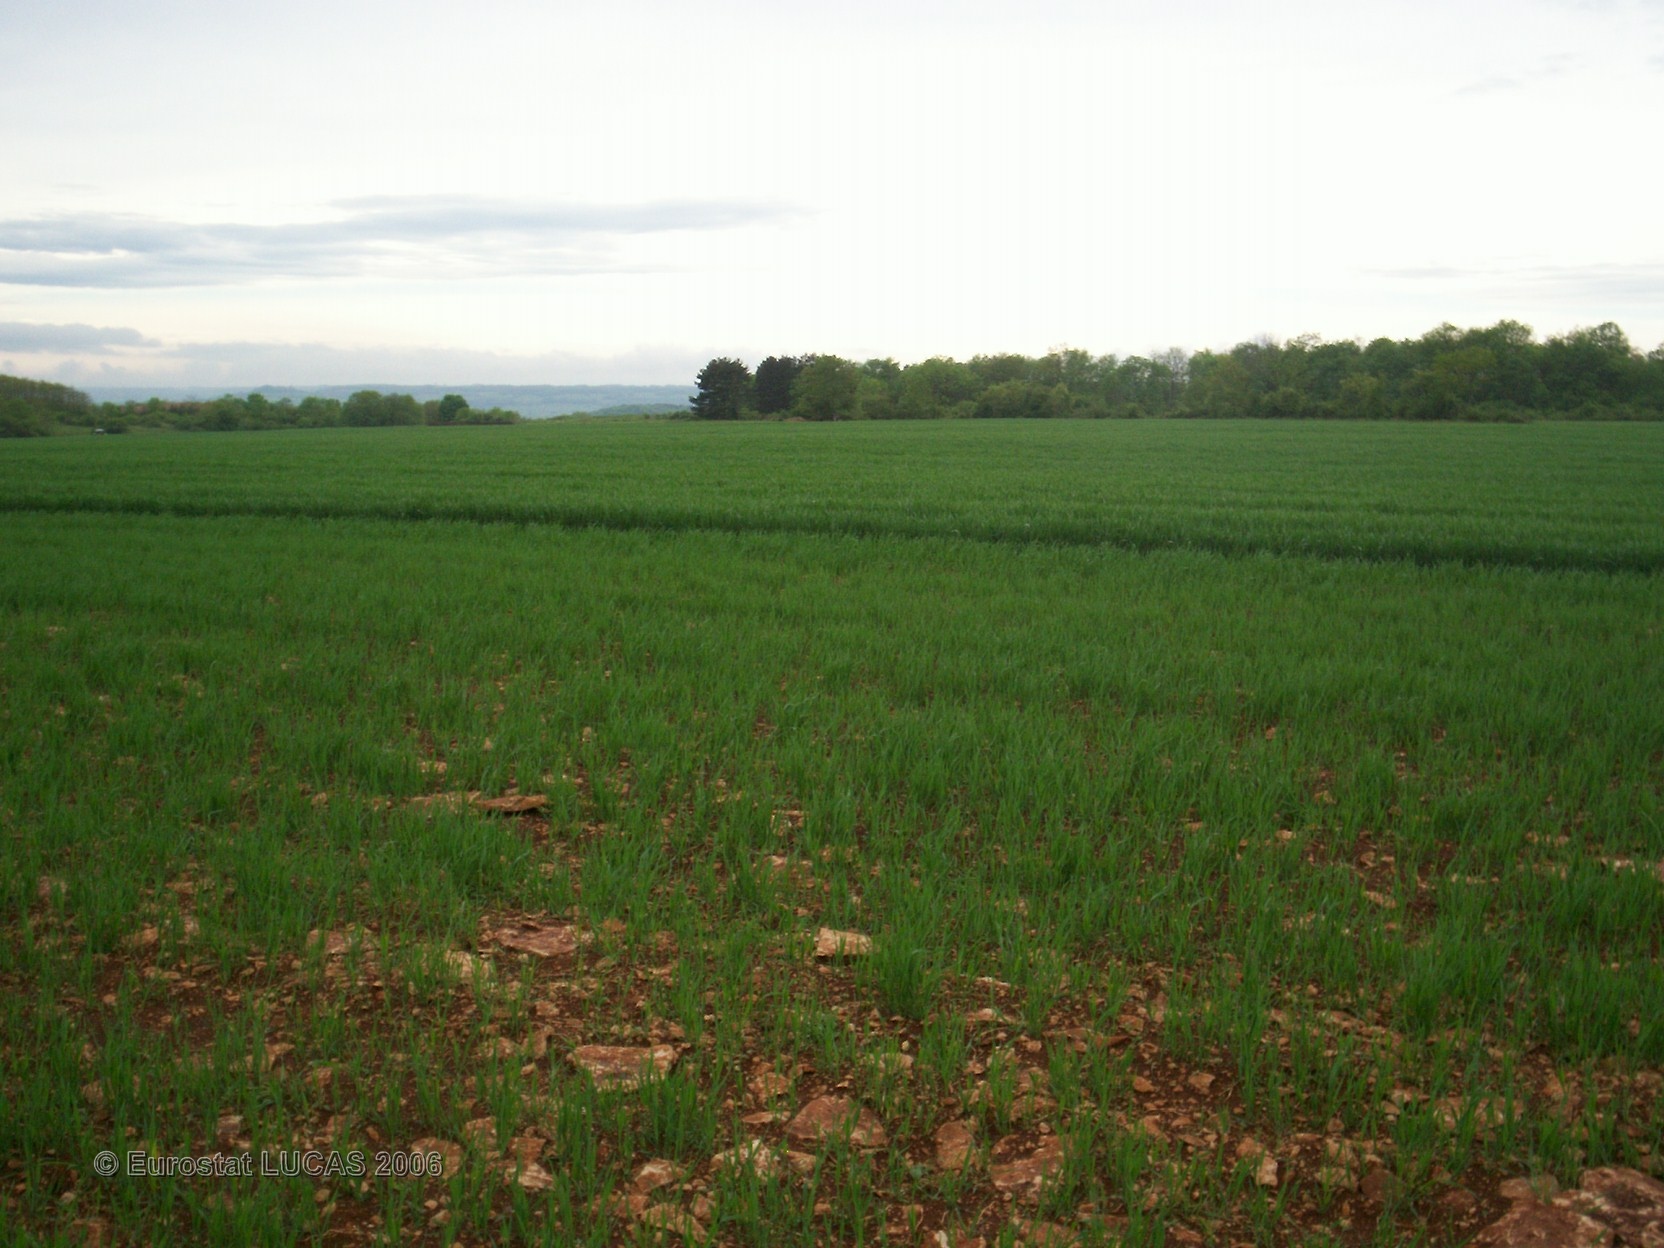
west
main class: Cropland
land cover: Oats
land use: Agriculture (excluding fallow land and kitchen gardens)
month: May
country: FR
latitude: 47.2612
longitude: 4.5946
